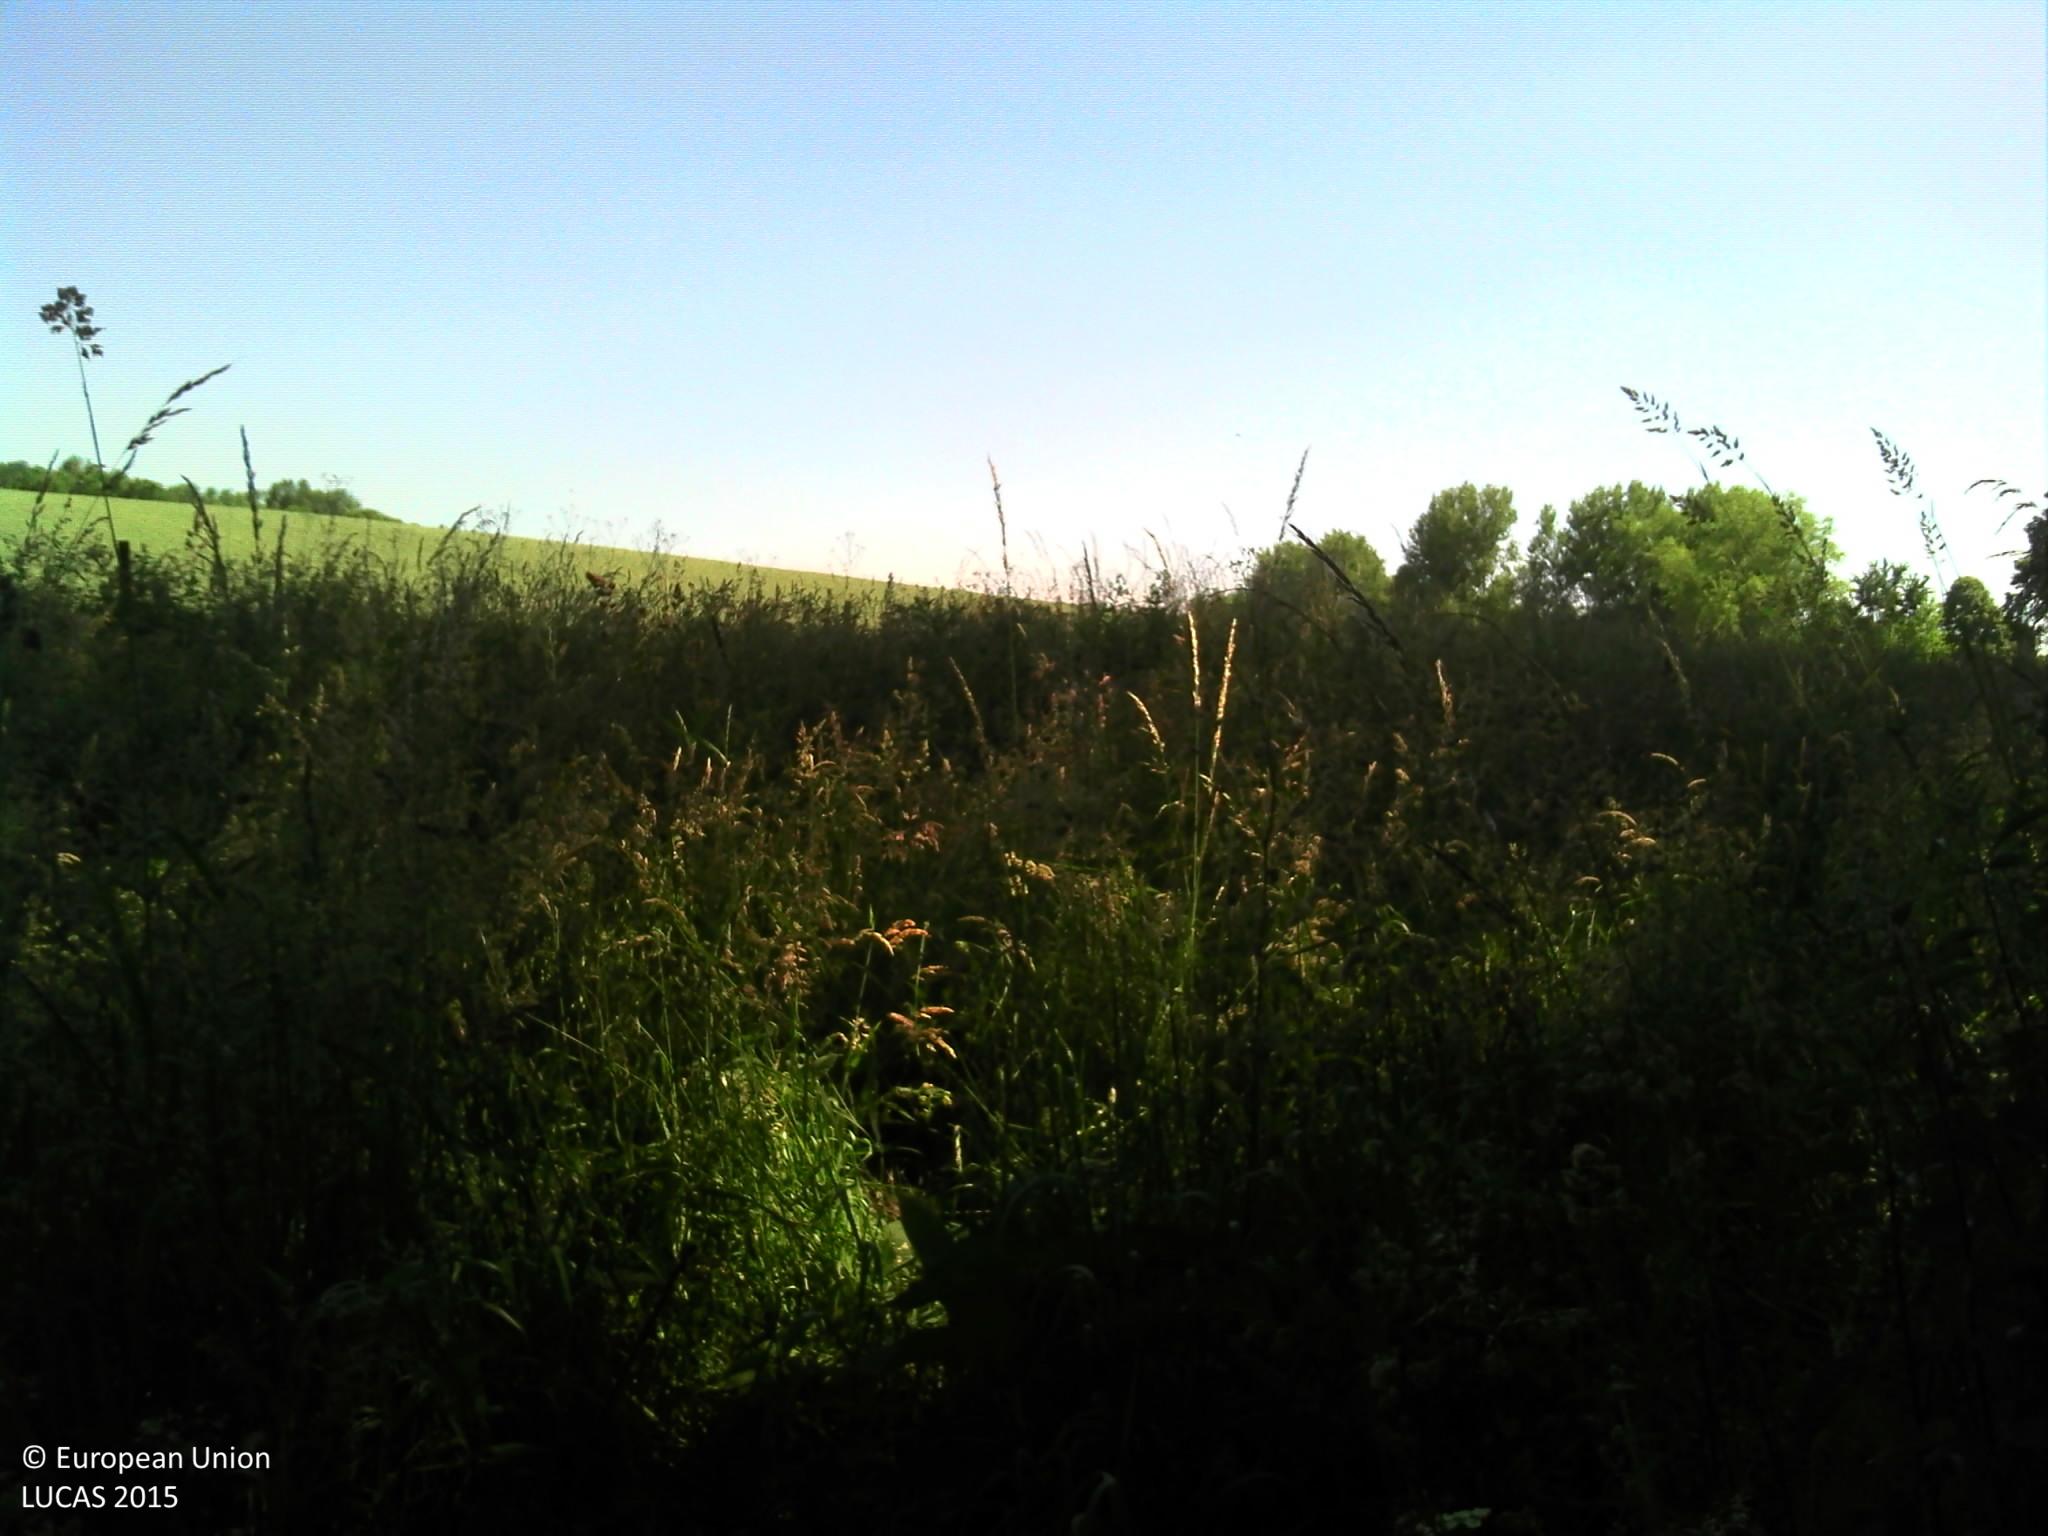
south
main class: Grassland
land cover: Grassland without tree/shrub cover
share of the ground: > 75 %
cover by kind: herbaceous plants 100 %
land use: Residential
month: June
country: BE
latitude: 50.7993
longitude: 3.6221
